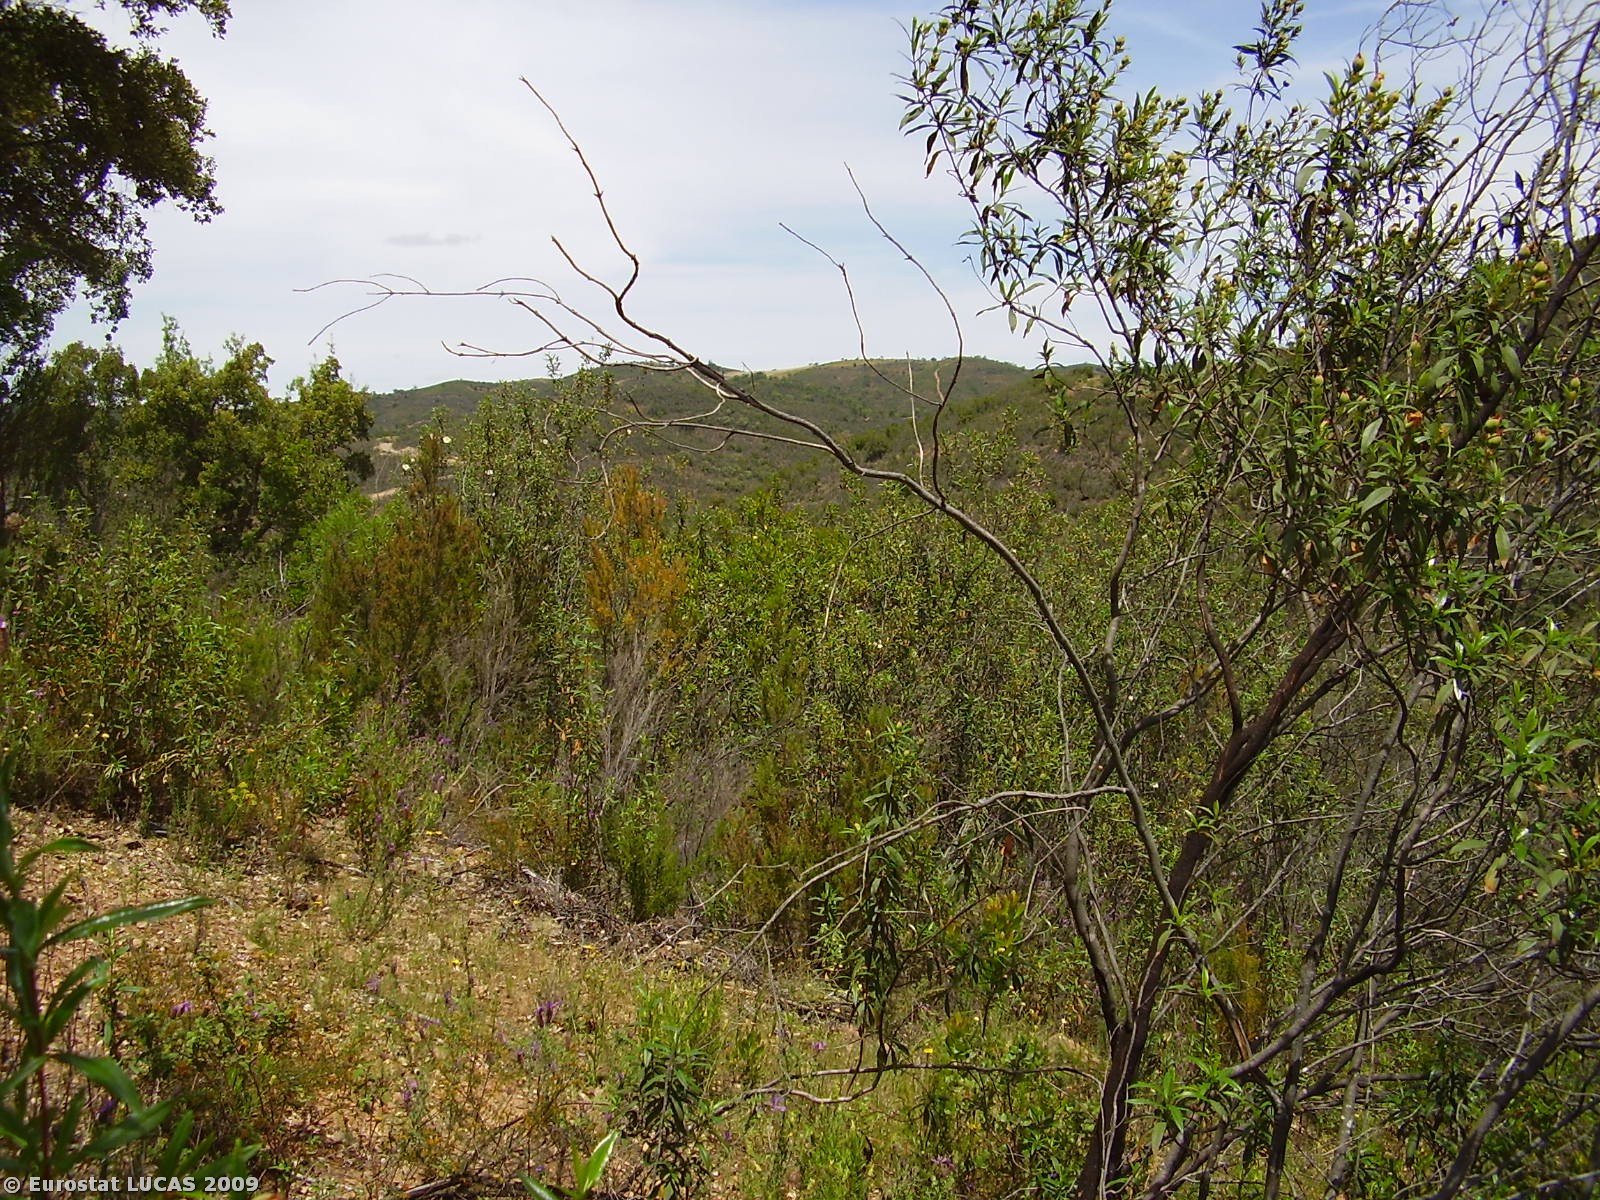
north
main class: Shrubland
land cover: Shrubland with sparse tree cover
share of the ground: > 75 %
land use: Fallow land
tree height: > 5 m
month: May
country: PT
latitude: 37.4149
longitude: -8.2261
